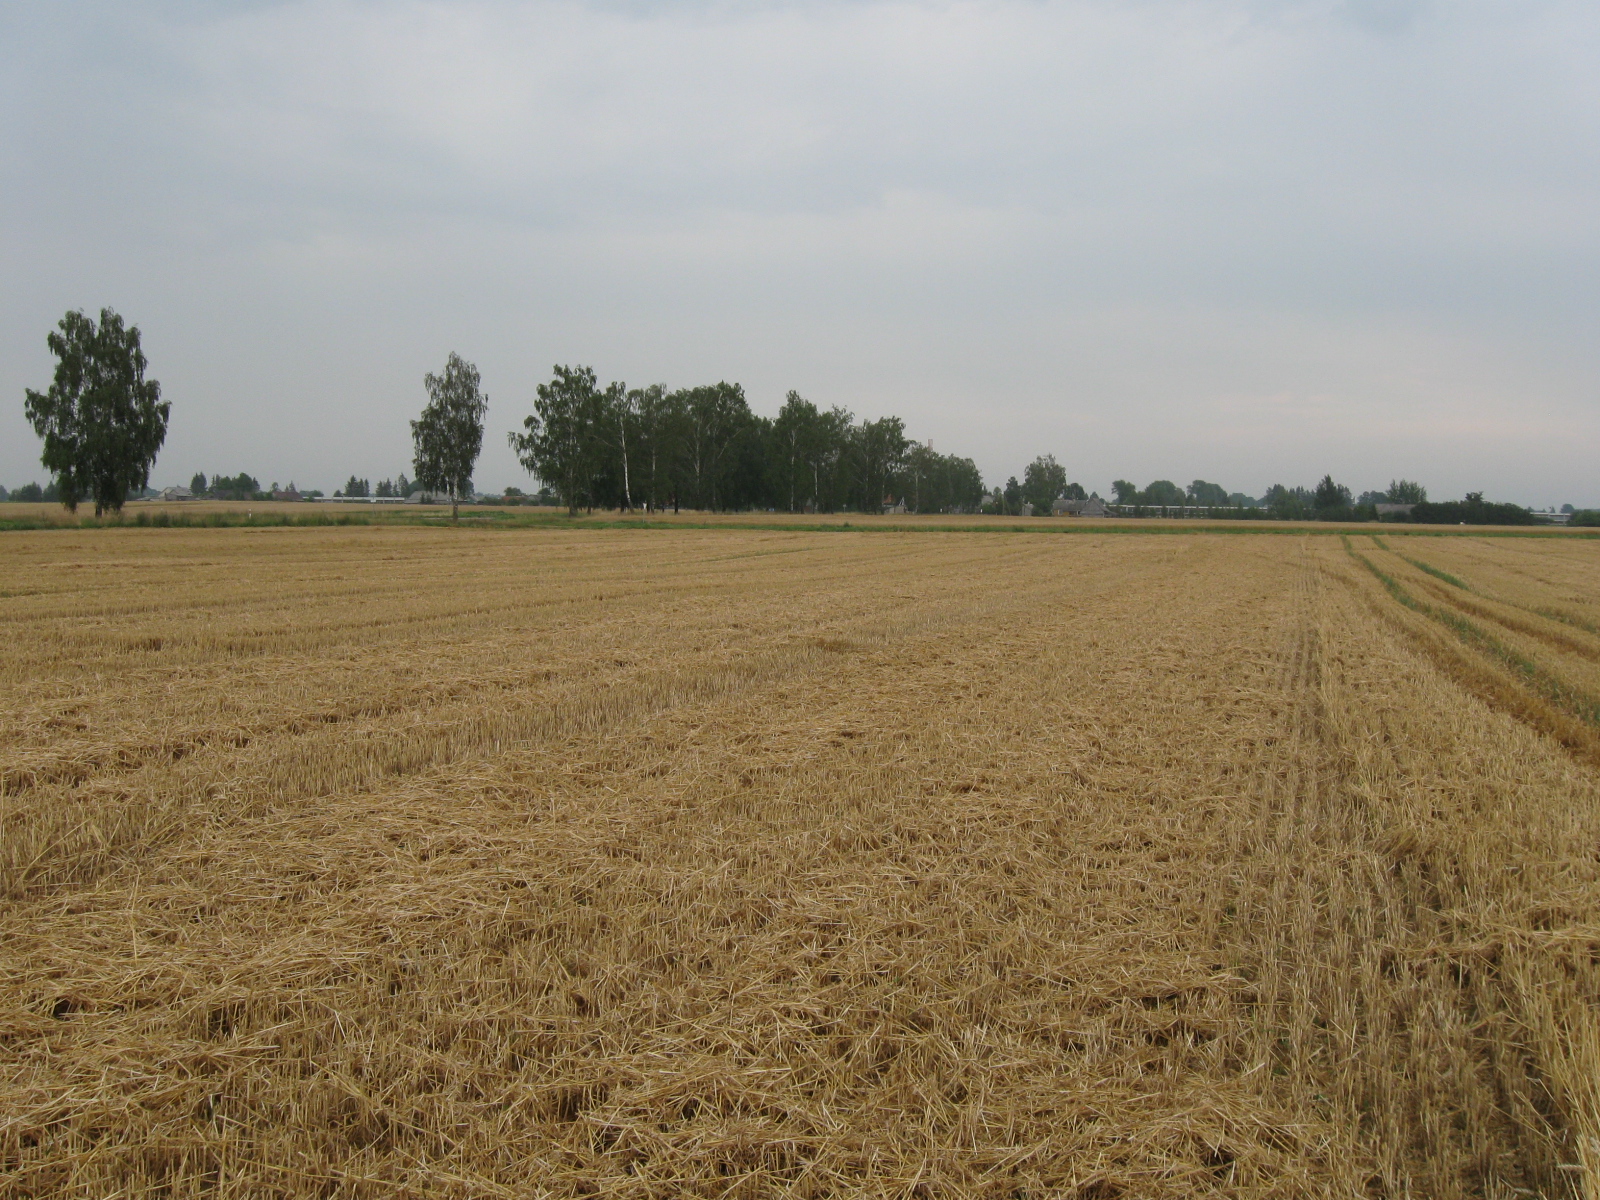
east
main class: Cropland
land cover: Common wheat
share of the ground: > 75 %
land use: Agriculture (excluding fallow land and kitchen gardens)
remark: Harvested field
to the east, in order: Common wheat; Grass margins; Tracks; Grass margins; Common wheat
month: August
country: LT
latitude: 54.6741
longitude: 23.4321
